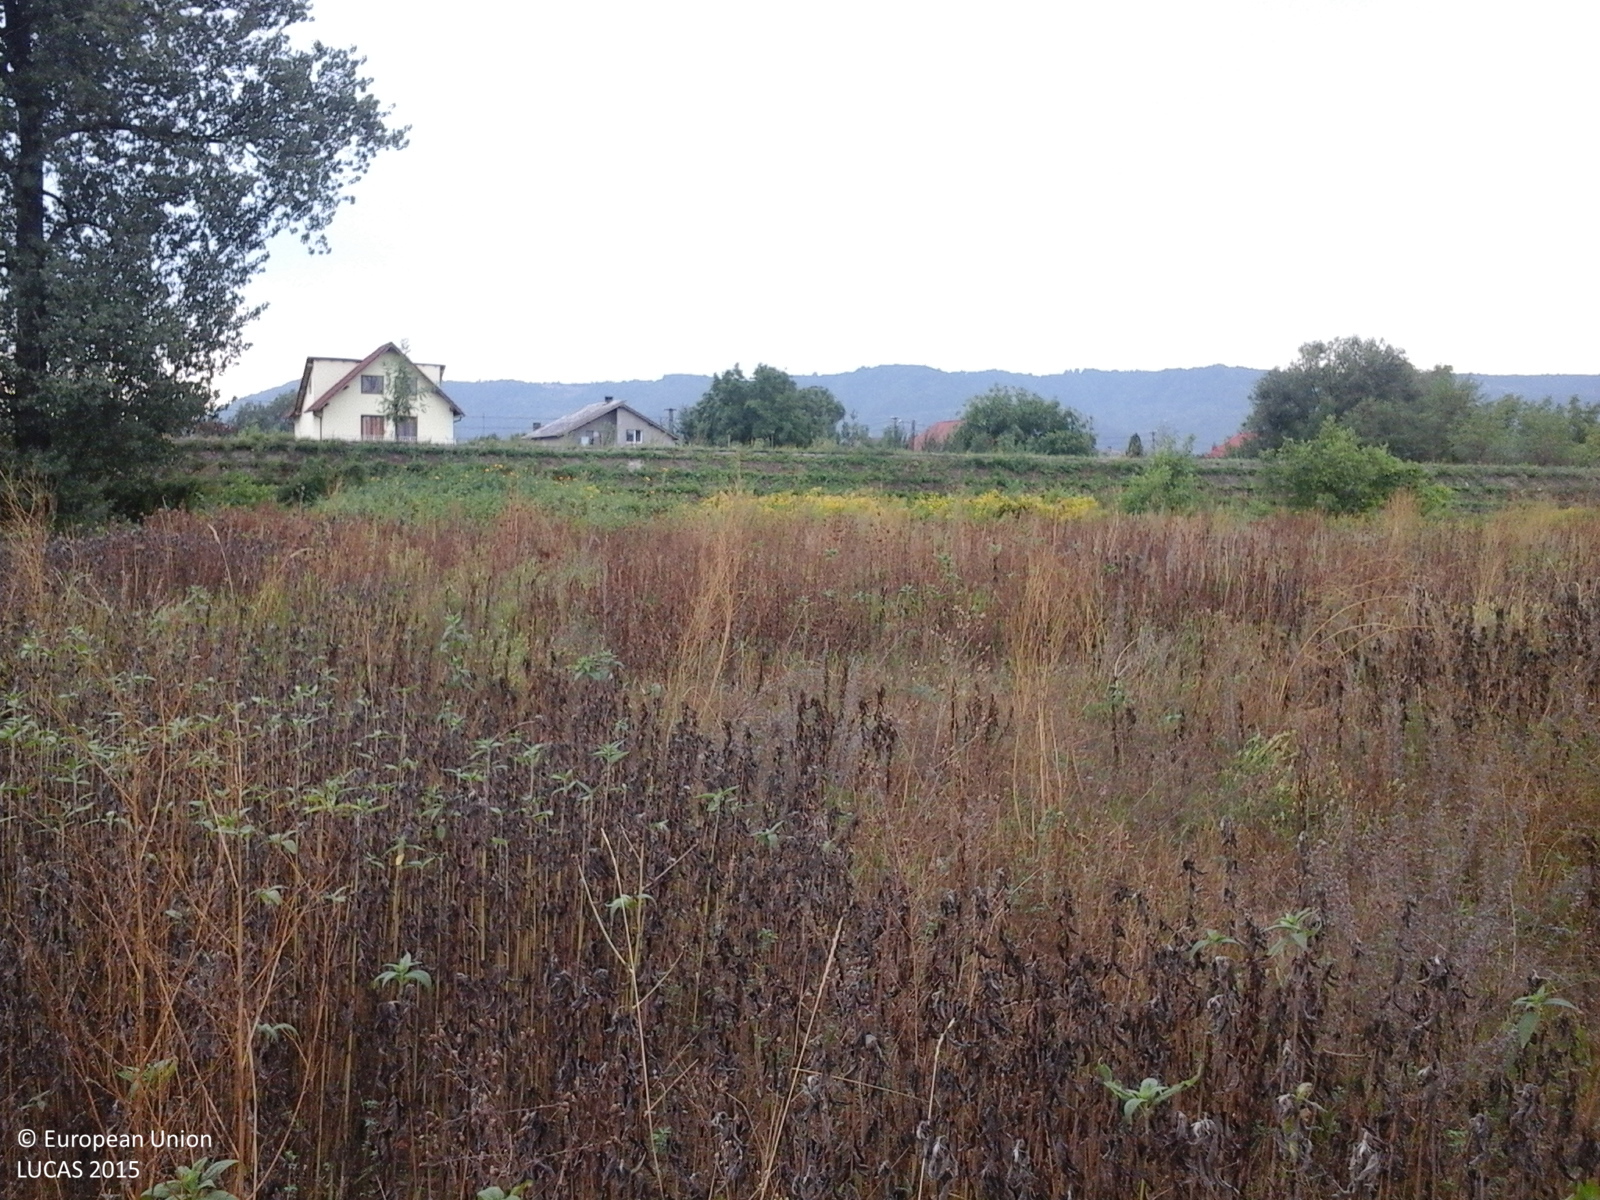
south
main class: Grassland
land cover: Spontaneously vegetated surfaces
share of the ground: > 75 %
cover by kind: herbaceous plants 100 %
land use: Fallow land
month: September
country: RO
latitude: 47.9418
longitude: 23.8862
